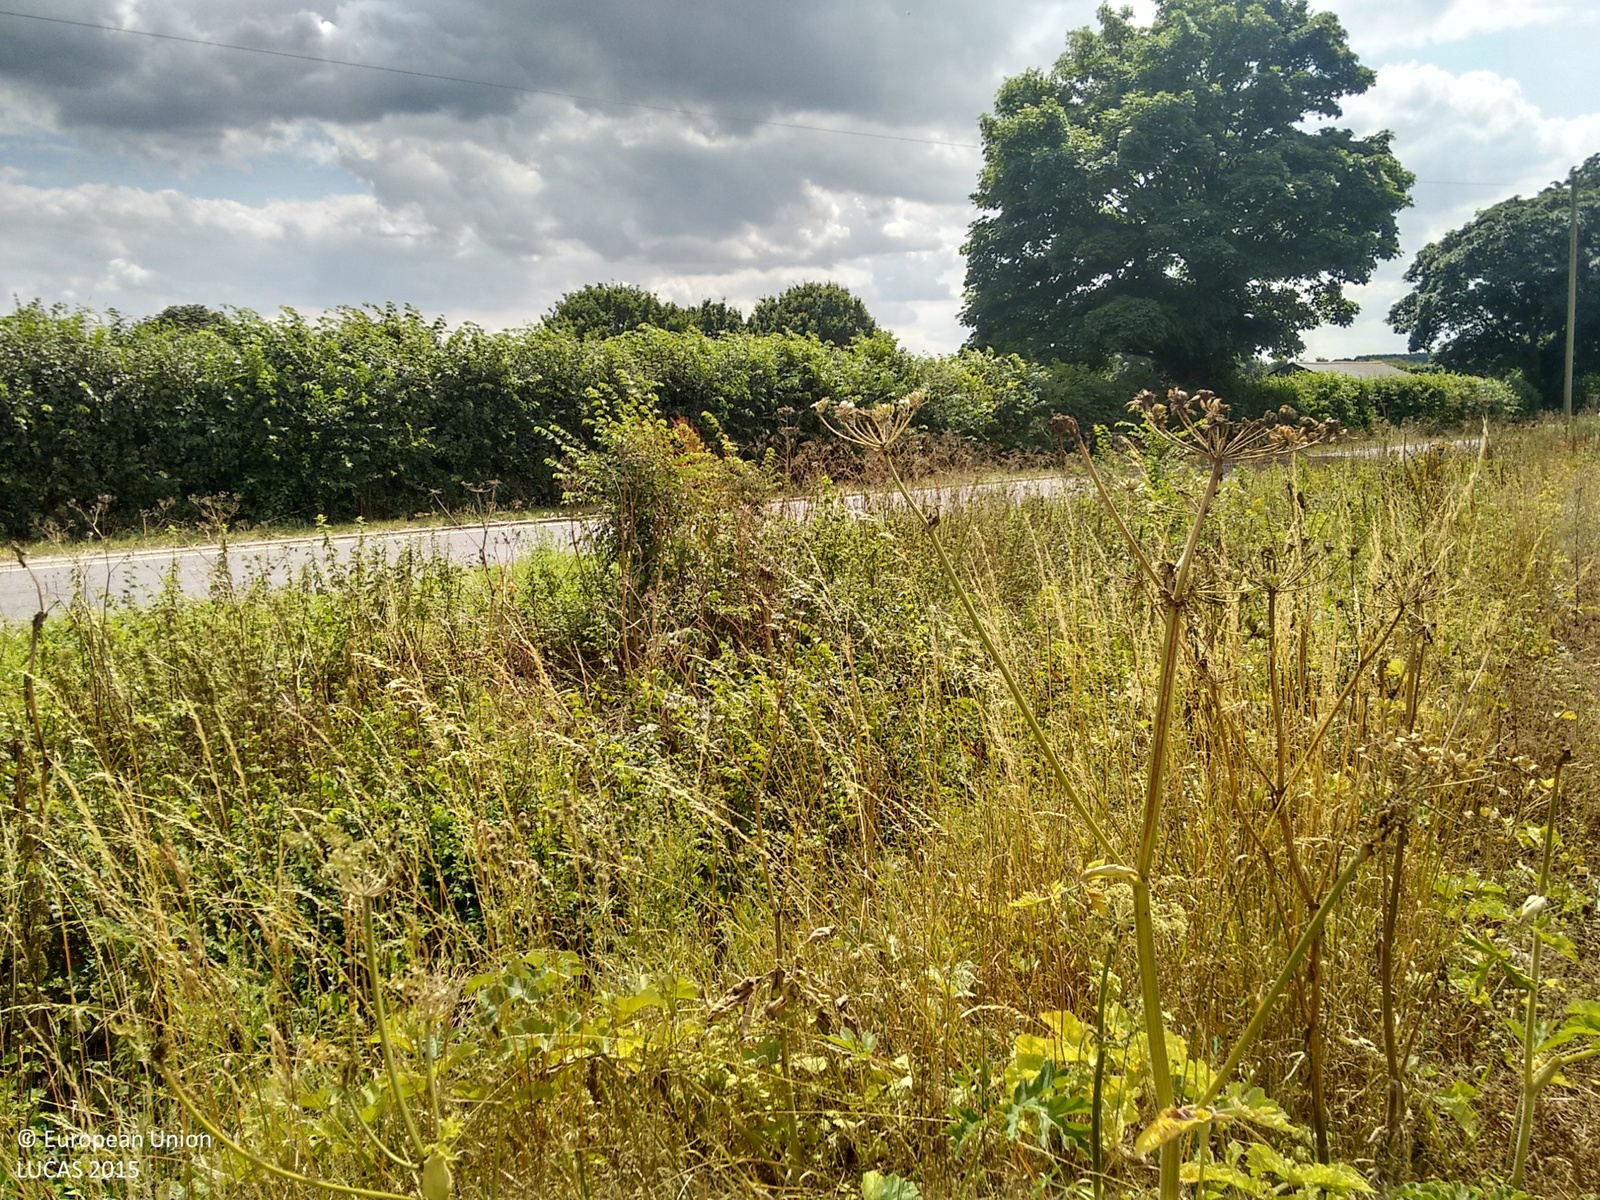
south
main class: Cropland
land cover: Rape and turnip rape
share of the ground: > 75 %
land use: Agriculture (excluding fallow land and kitchen gardens)
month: July
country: GB
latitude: 51.9036
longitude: 0.4810
